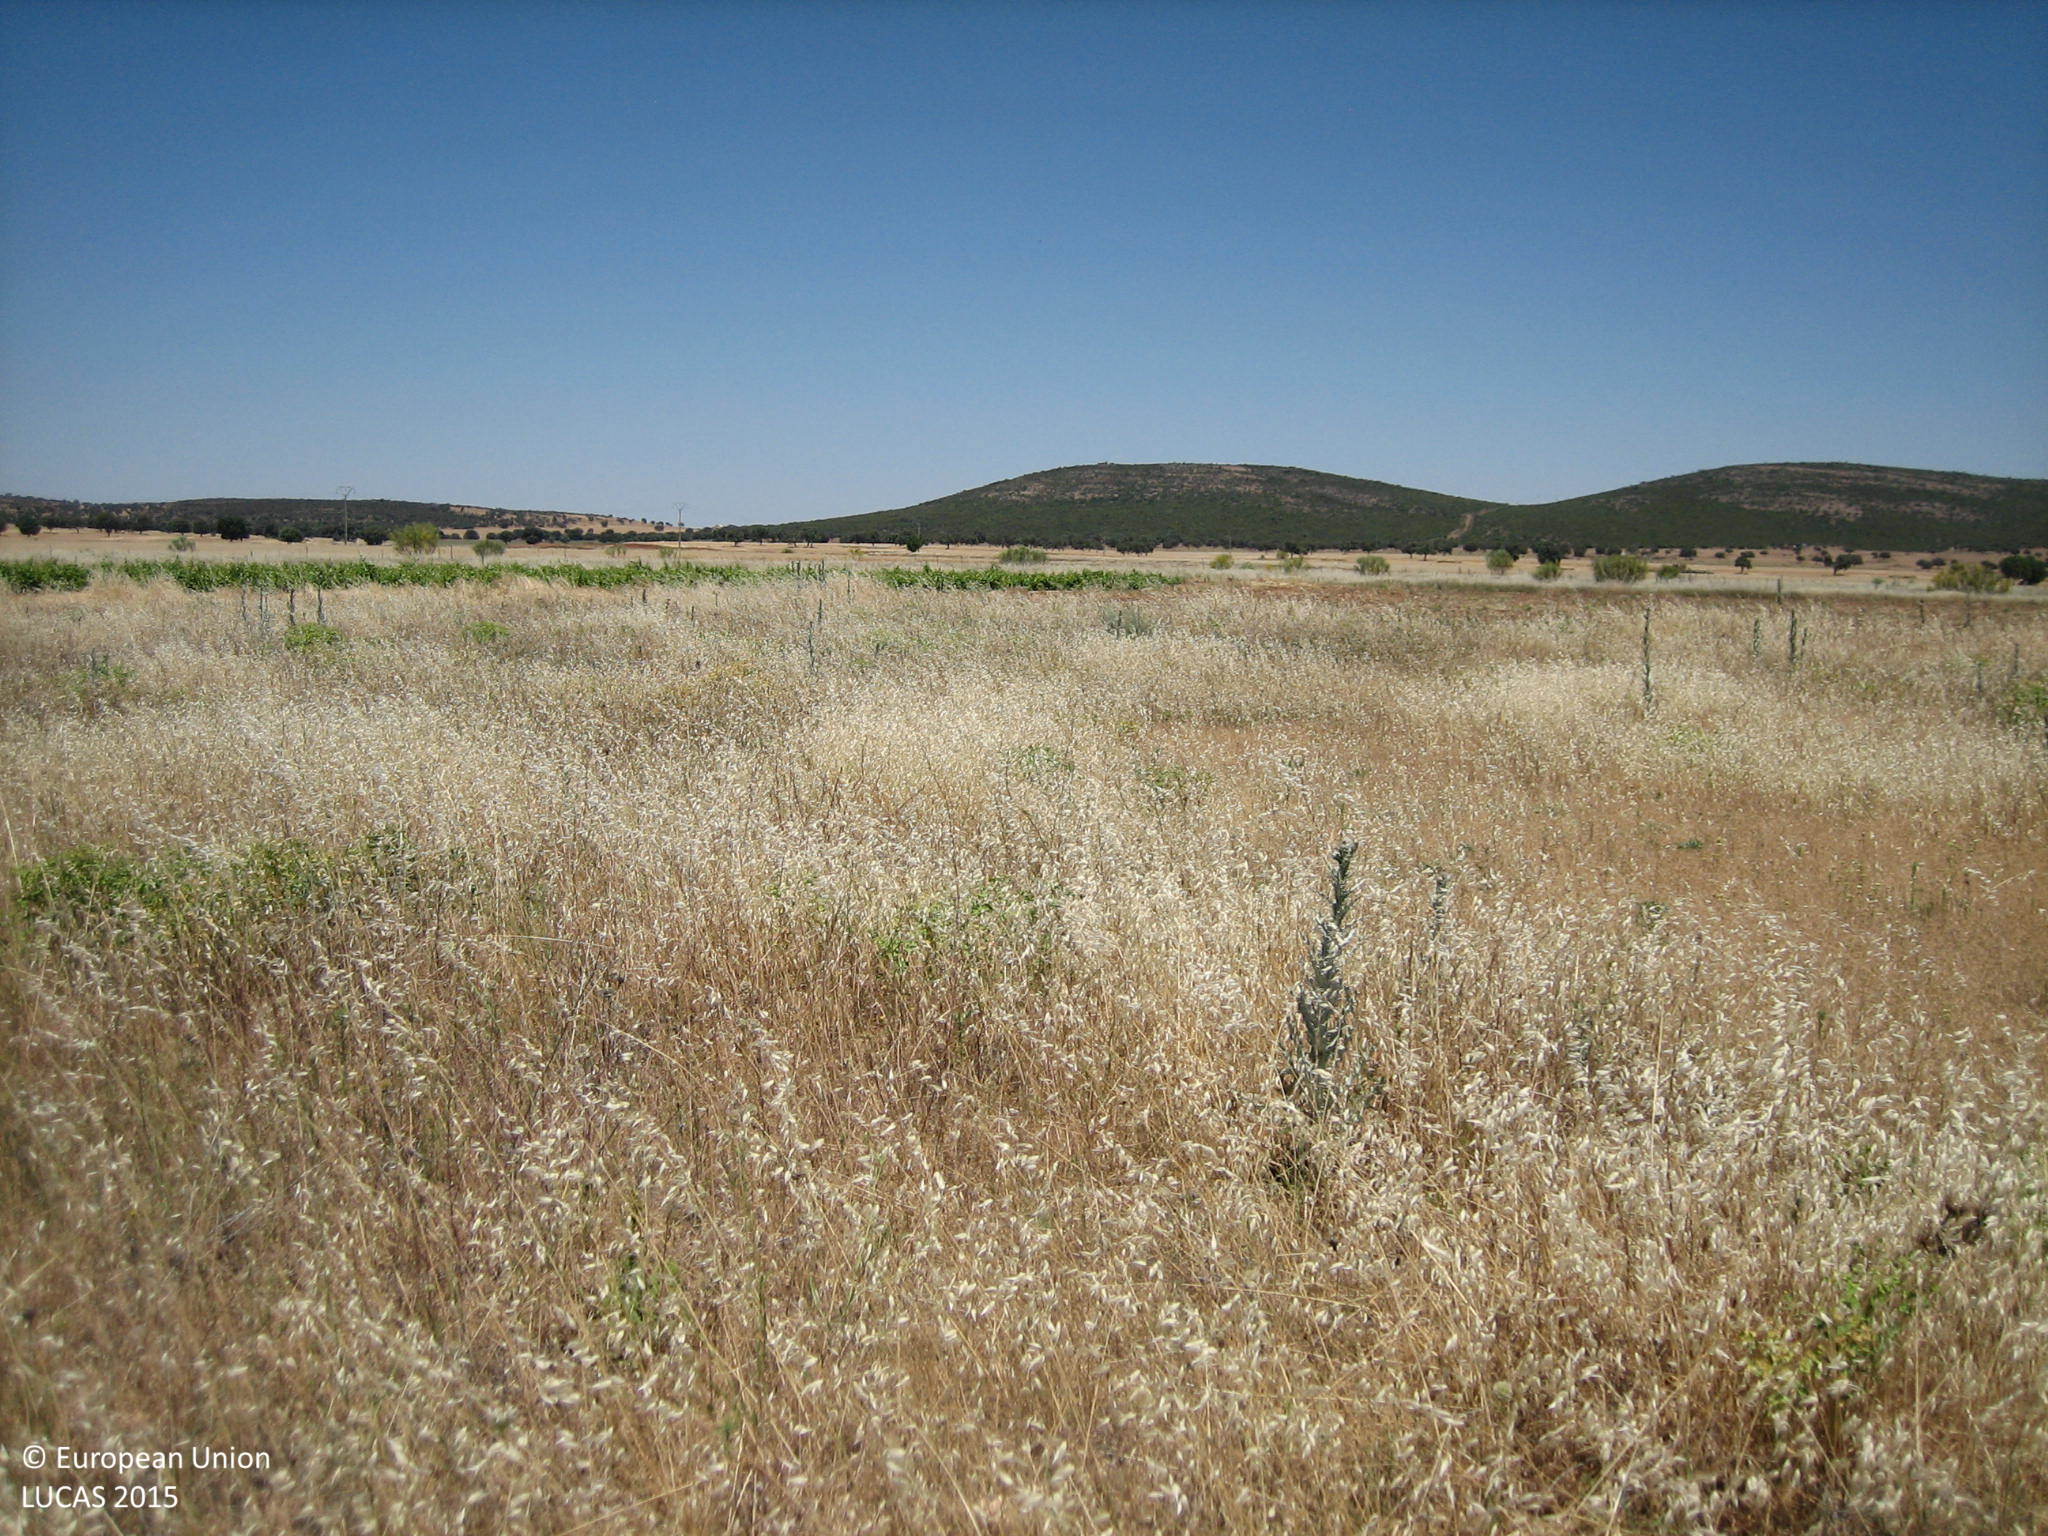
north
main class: Grassland
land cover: Spontaneously vegetated surfaces
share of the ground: > 75 %
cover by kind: herbaceous plants 100 %
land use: Fallow land
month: June
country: ES
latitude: 38.7772
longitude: -4.0271
